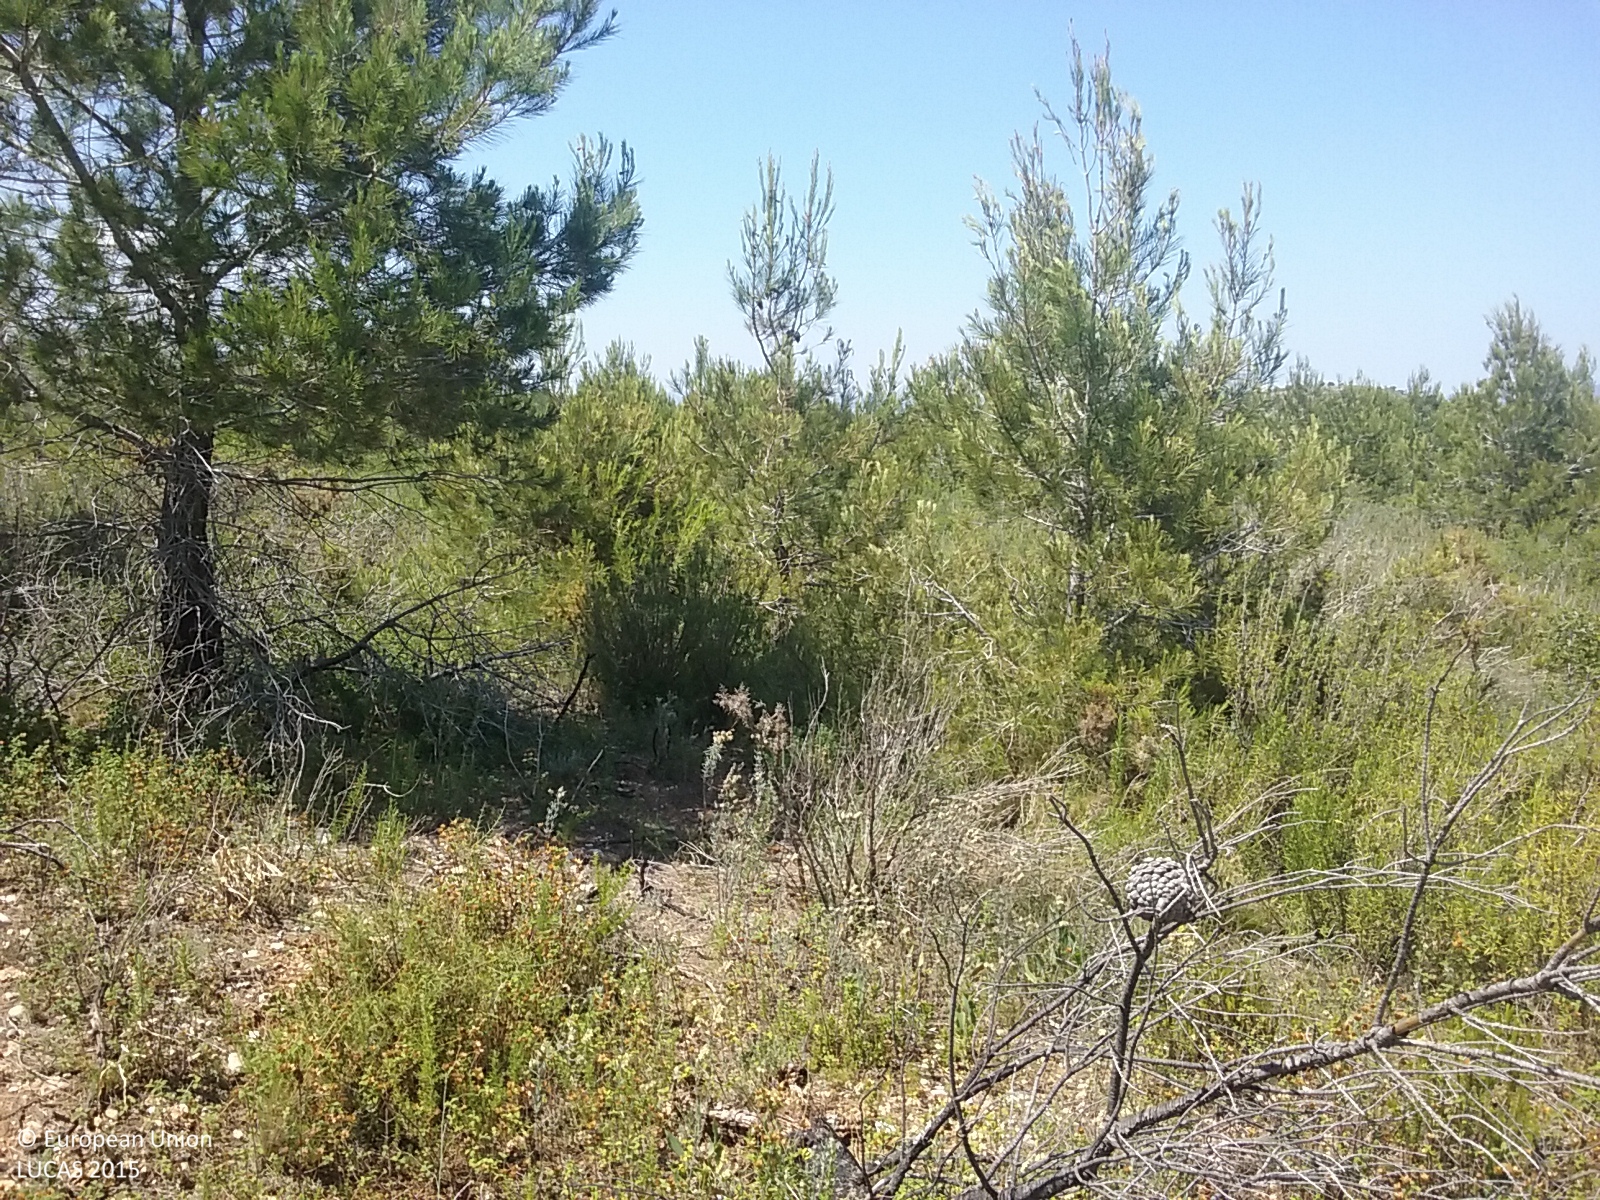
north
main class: Woodland
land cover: Pine dominated coniferous woodland
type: coniferous forest of the mediterranean region
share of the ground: 10 - 25 %
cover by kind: shrubs 75 %, coniferous forest trees 15 %, herbaceous plants 10 %
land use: Semi-natural and natural areas not in use
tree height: < 5 m
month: June
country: ES
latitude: 40.9297
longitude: 0.6470
